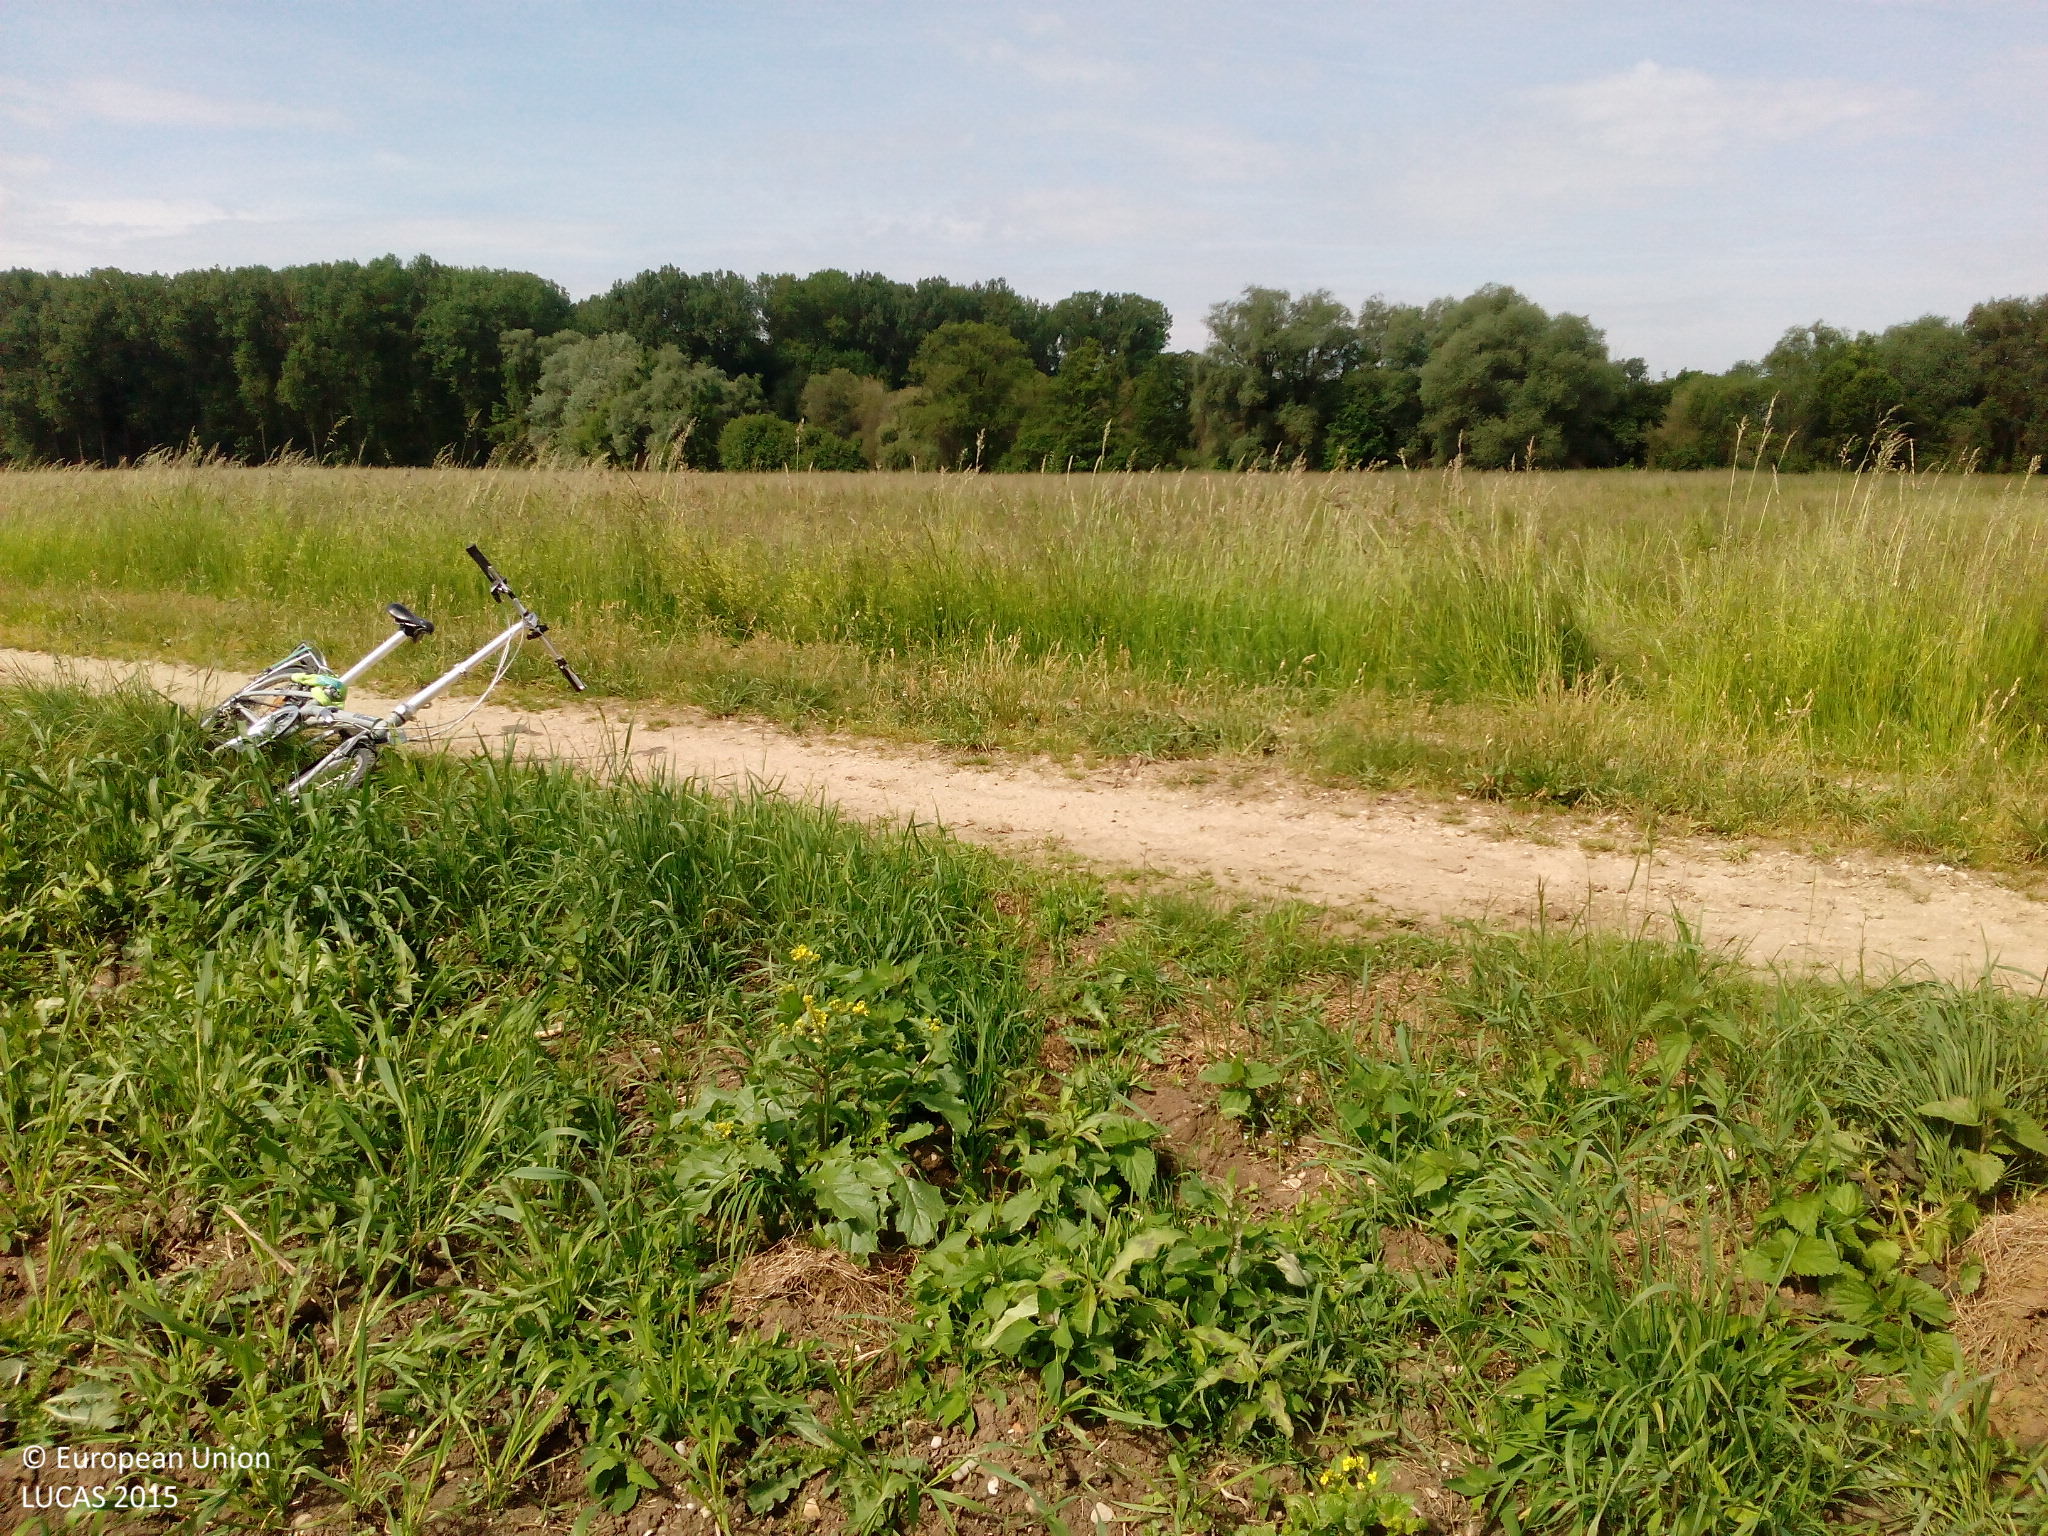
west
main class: Grassland
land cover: Spontaneously vegetated surfaces
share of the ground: 25 - 50 %
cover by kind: unconsolidated bare surface 60 %, herbaceous plants 40 %
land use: Agriculture (excluding fallow land and kitchen gardens)
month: May
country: DE
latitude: 48.6995
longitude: 11.4803
